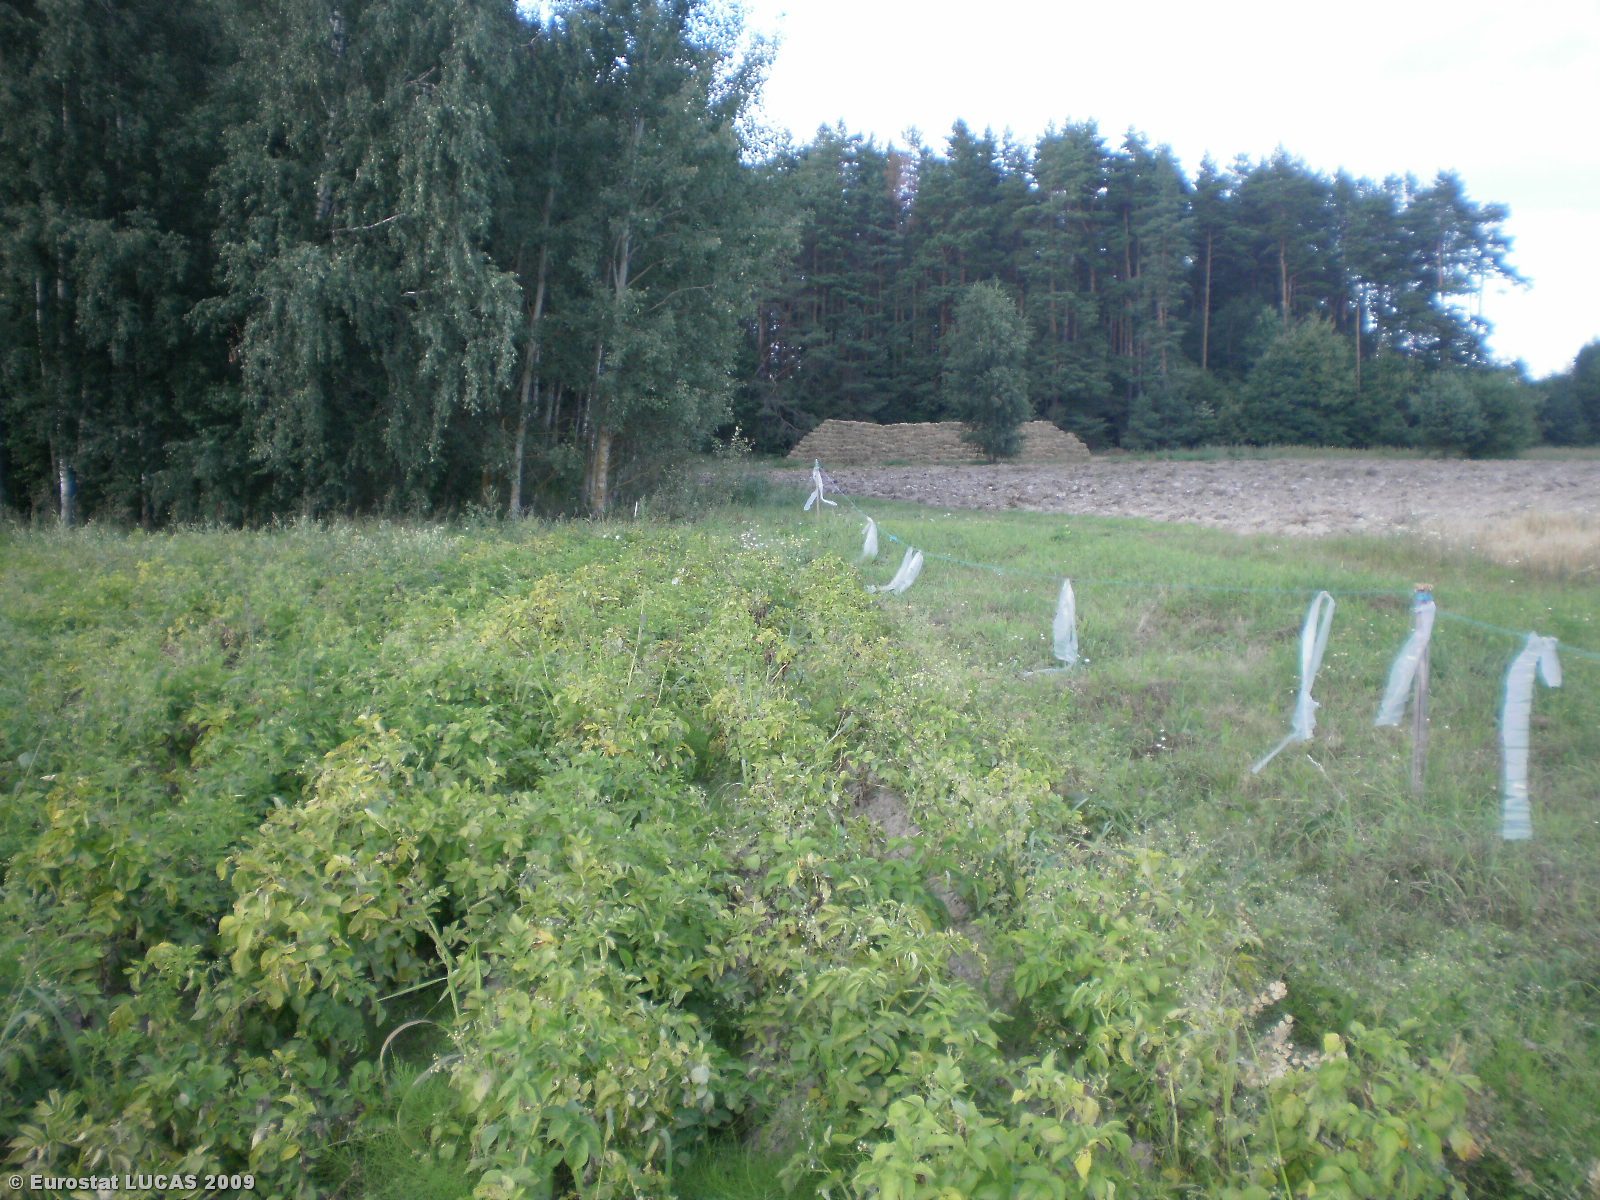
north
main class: Cropland
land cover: Potatoes
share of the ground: > 75 %
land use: Kitchen garden
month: August
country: LT
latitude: 55.3804
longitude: 24.9306
